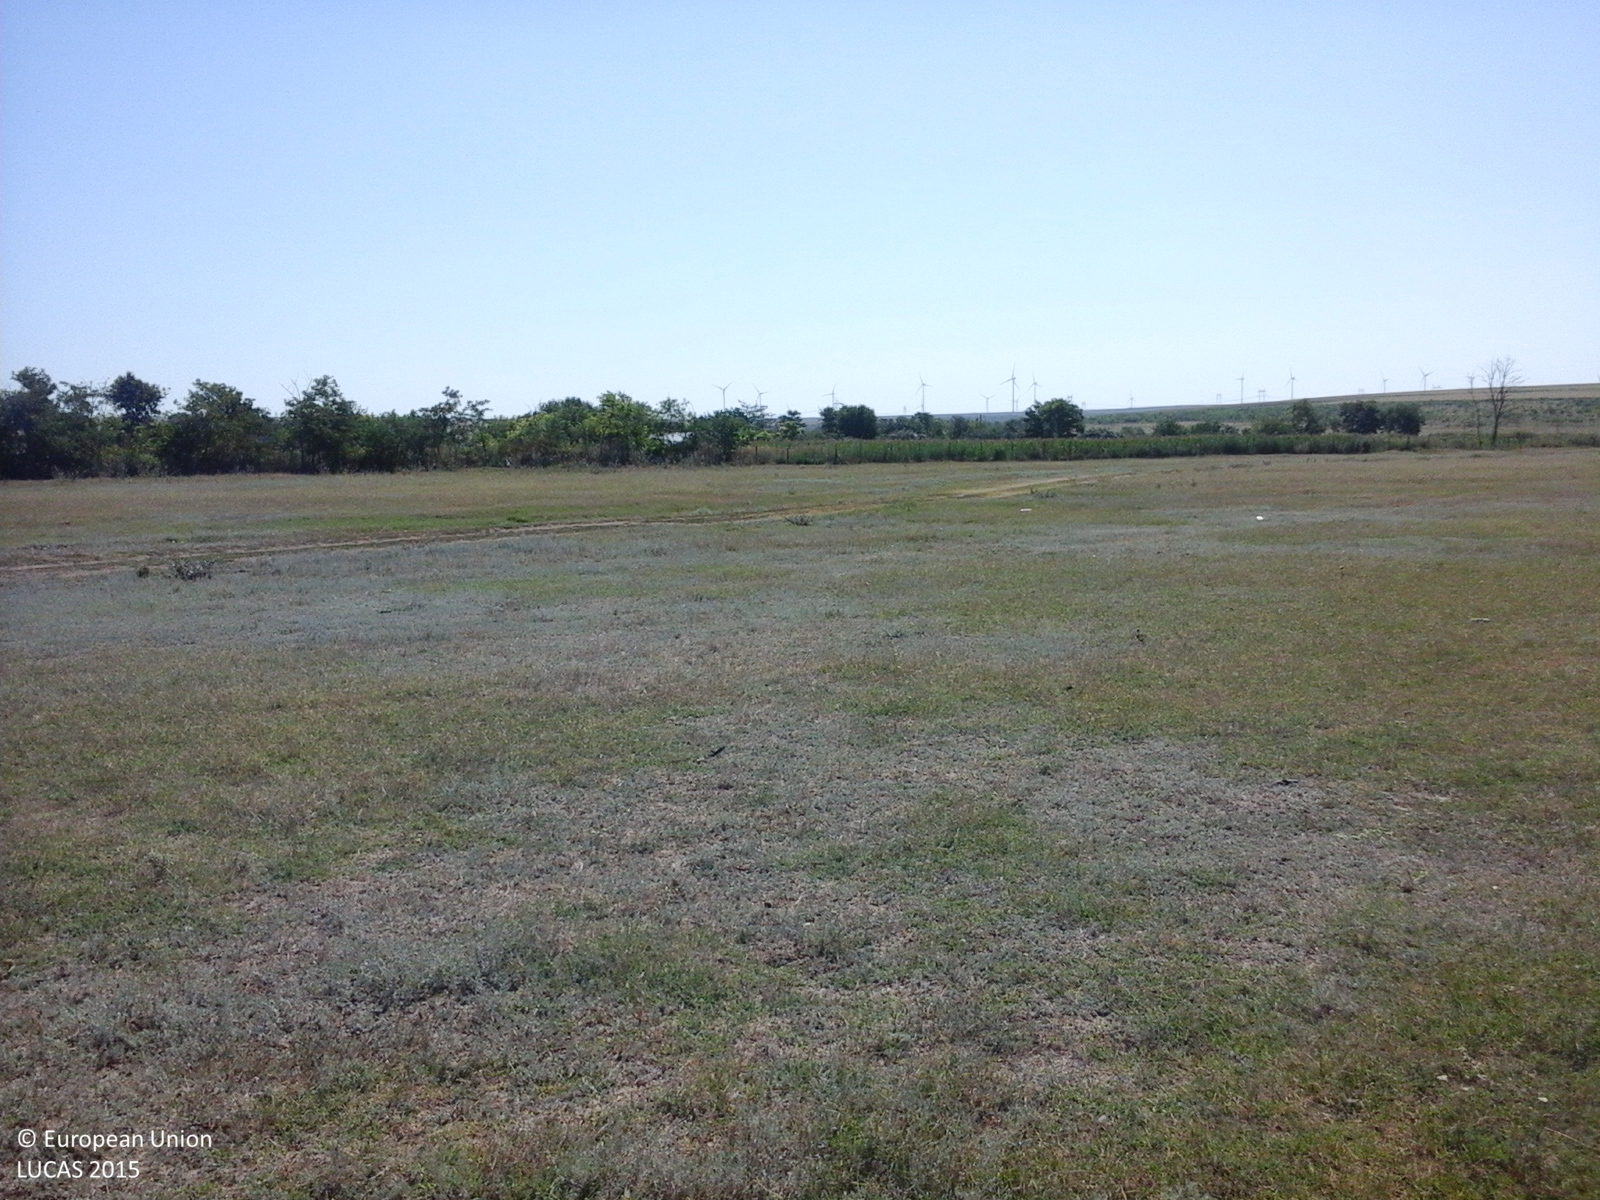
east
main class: Grassland
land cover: Grassland without tree/shrub cover
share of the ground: > 75 %
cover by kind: herbaceous plants 100 %
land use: Agriculture (excluding fallow land and kitchen gardens)
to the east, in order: Grassland without tree/shrub cover; Tracks; Grassland without tree/shrub cover; Tracks; Spontaneously vegetated surfaces; Fences; Abandoned hedges; Maize; Artificial constructions in urban areas
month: August
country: RO
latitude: 44.6290
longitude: 28.1772
